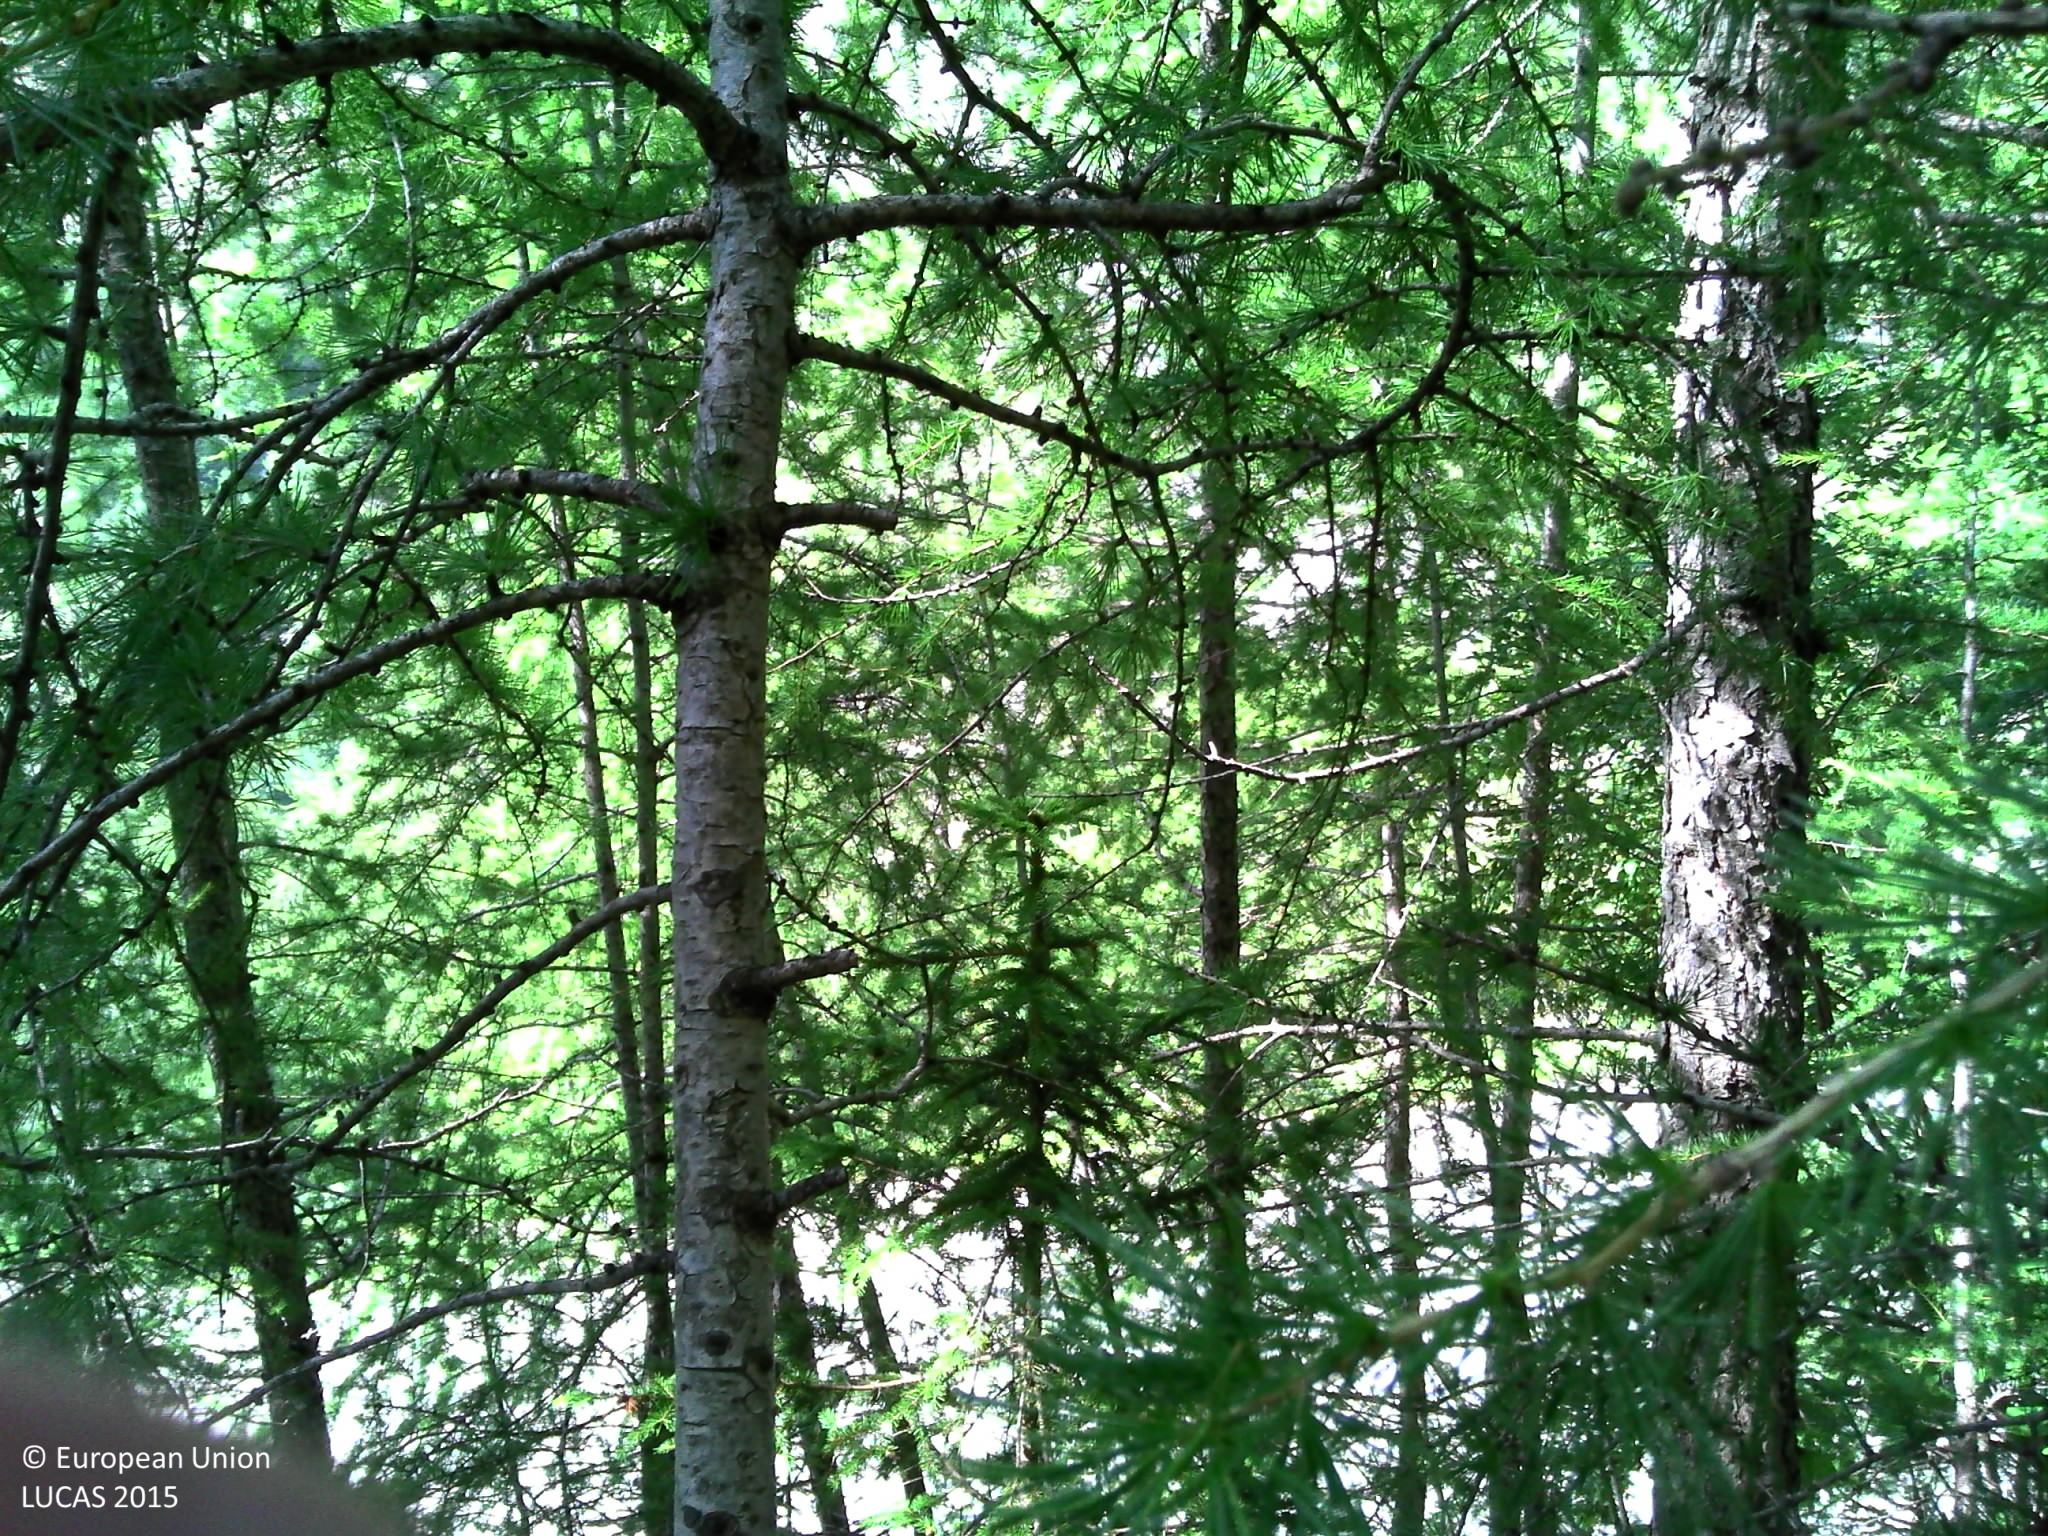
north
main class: Woodland
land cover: Other coniferous woodland
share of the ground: > 75 %
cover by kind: coniferous forest trees 60 %, broadleaved forest trees 20 %, herbaceous plants 15 %, unconsolidated bare surface 5 %
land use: Semi-natural and natural areas not in use
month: June
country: FR
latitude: 44.2015
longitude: 7.0906
